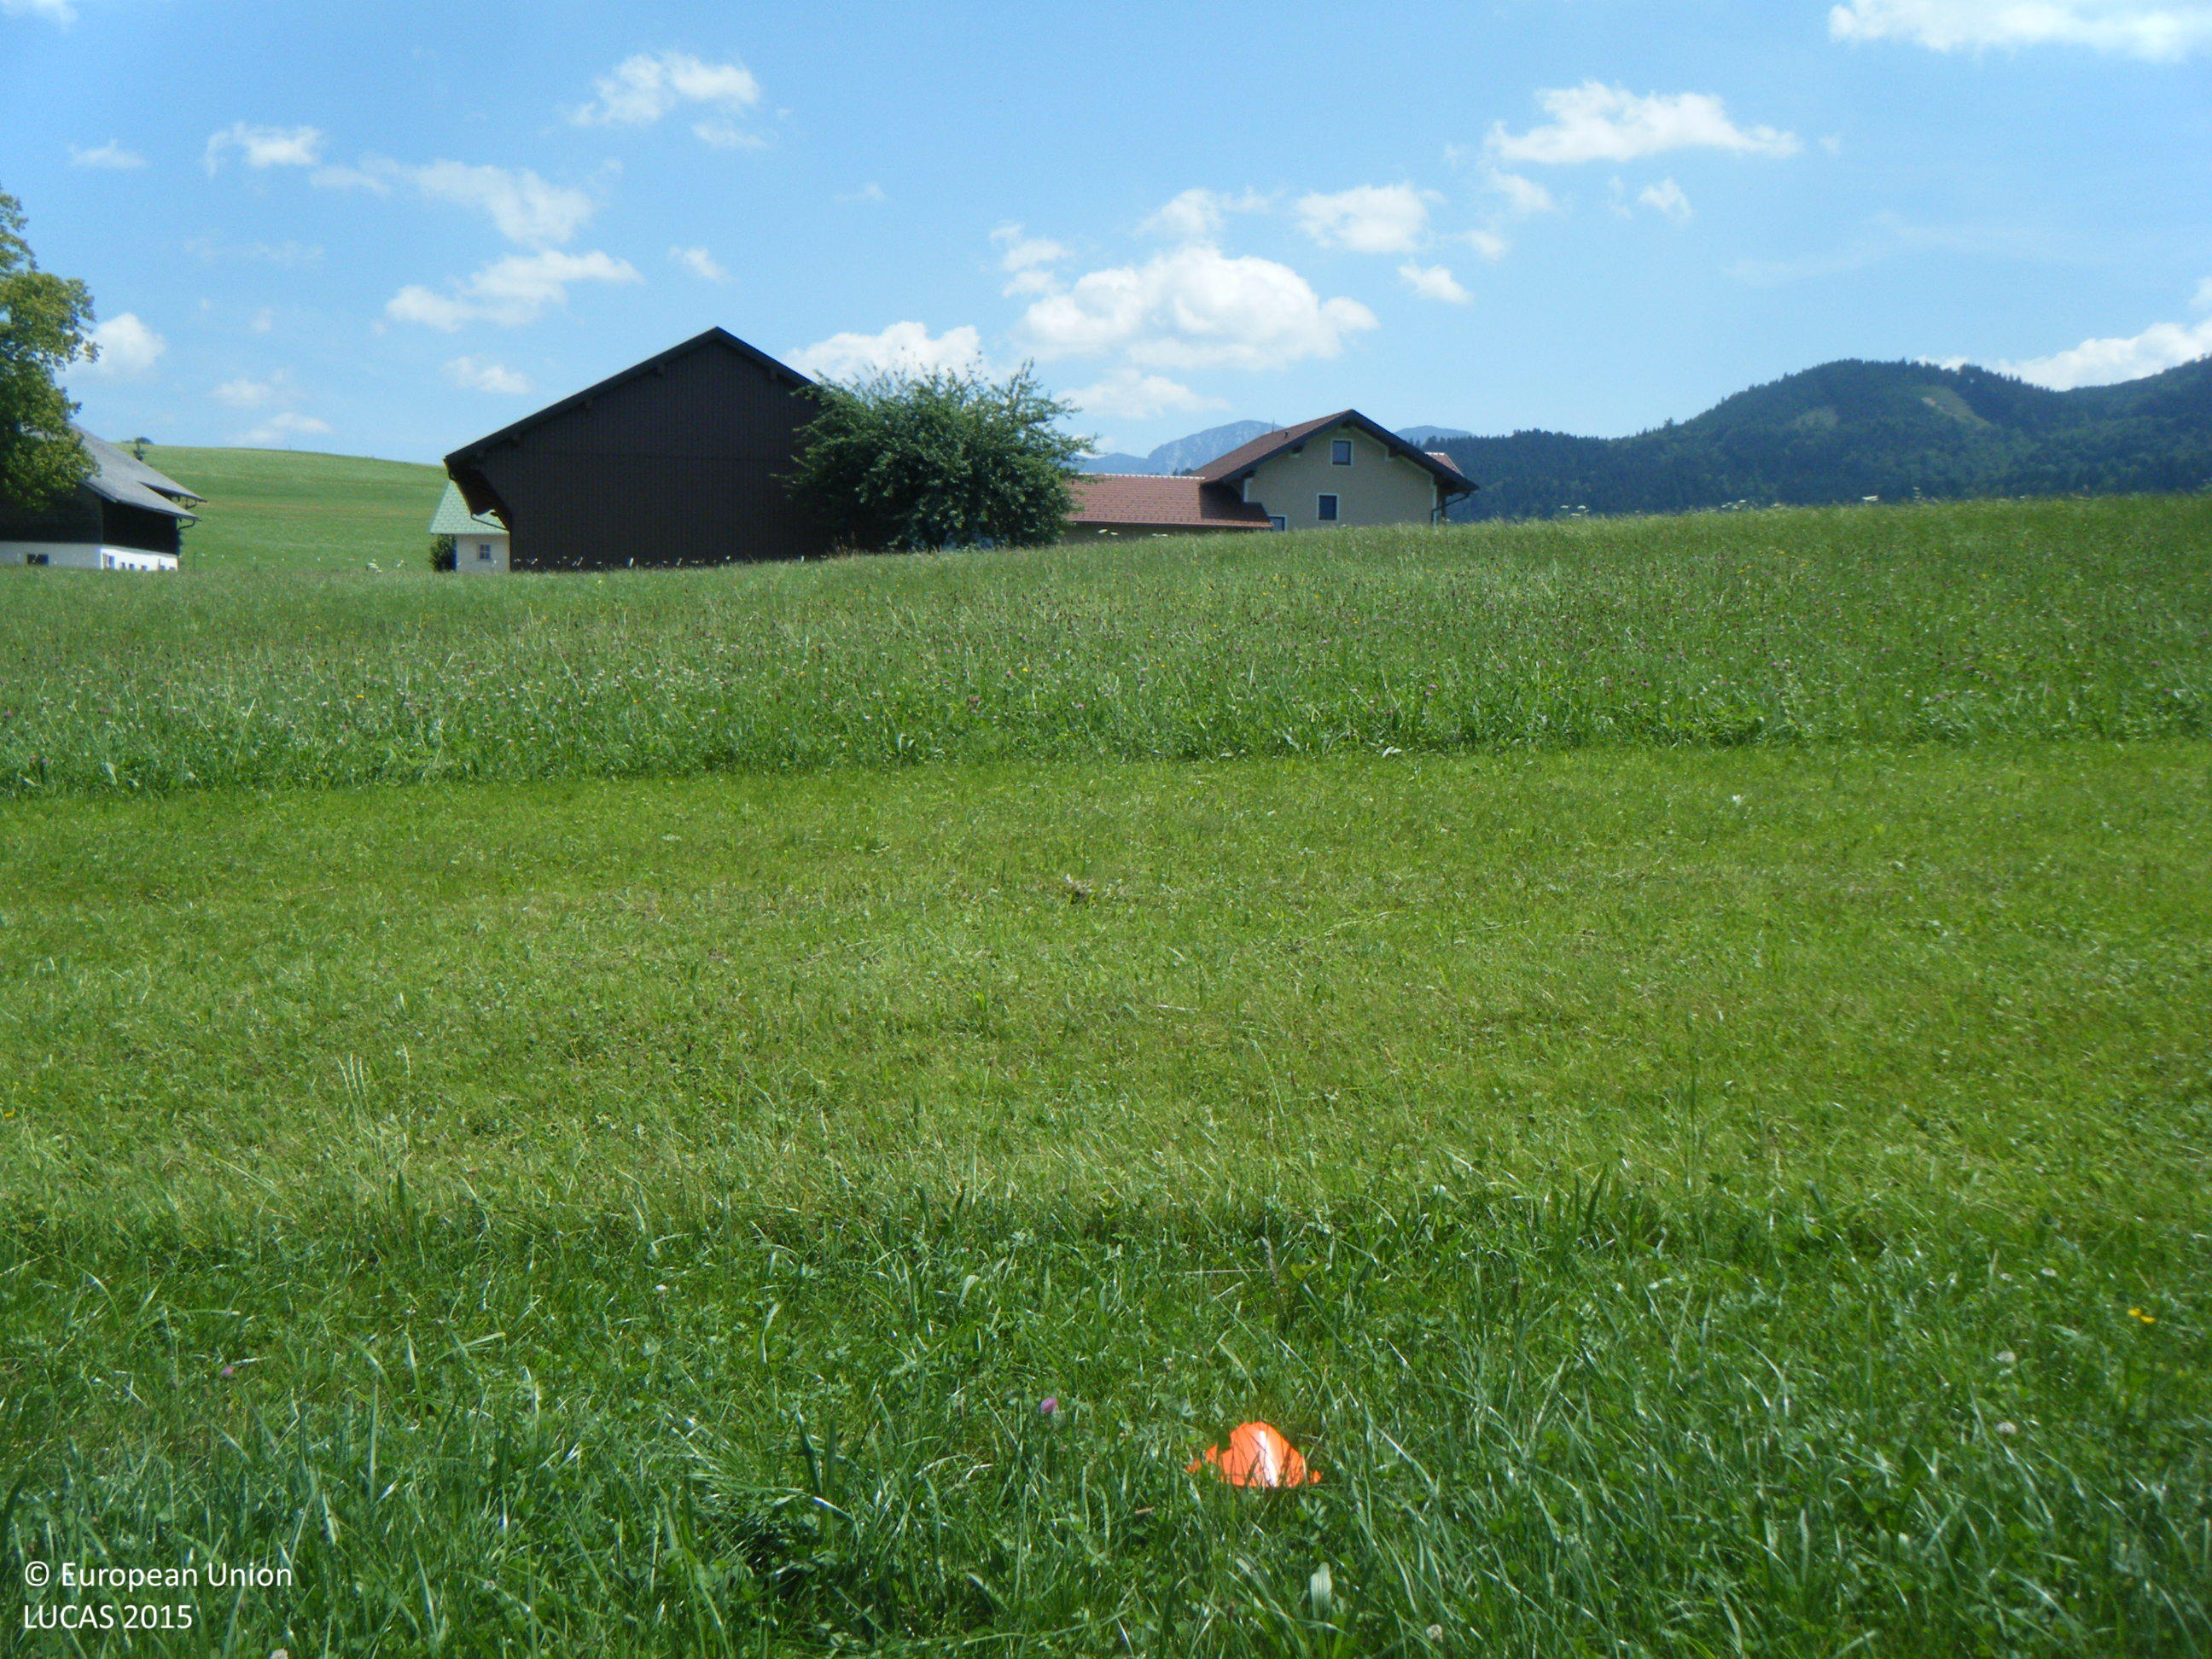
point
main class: Grassland
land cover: Grassland without tree/shrub cover
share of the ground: > 75 %
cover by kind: herbaceous plants 100 %
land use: Agriculture (excluding fallow land and kitchen gardens)
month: July
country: AT
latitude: 47.8451
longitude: 13.4598
